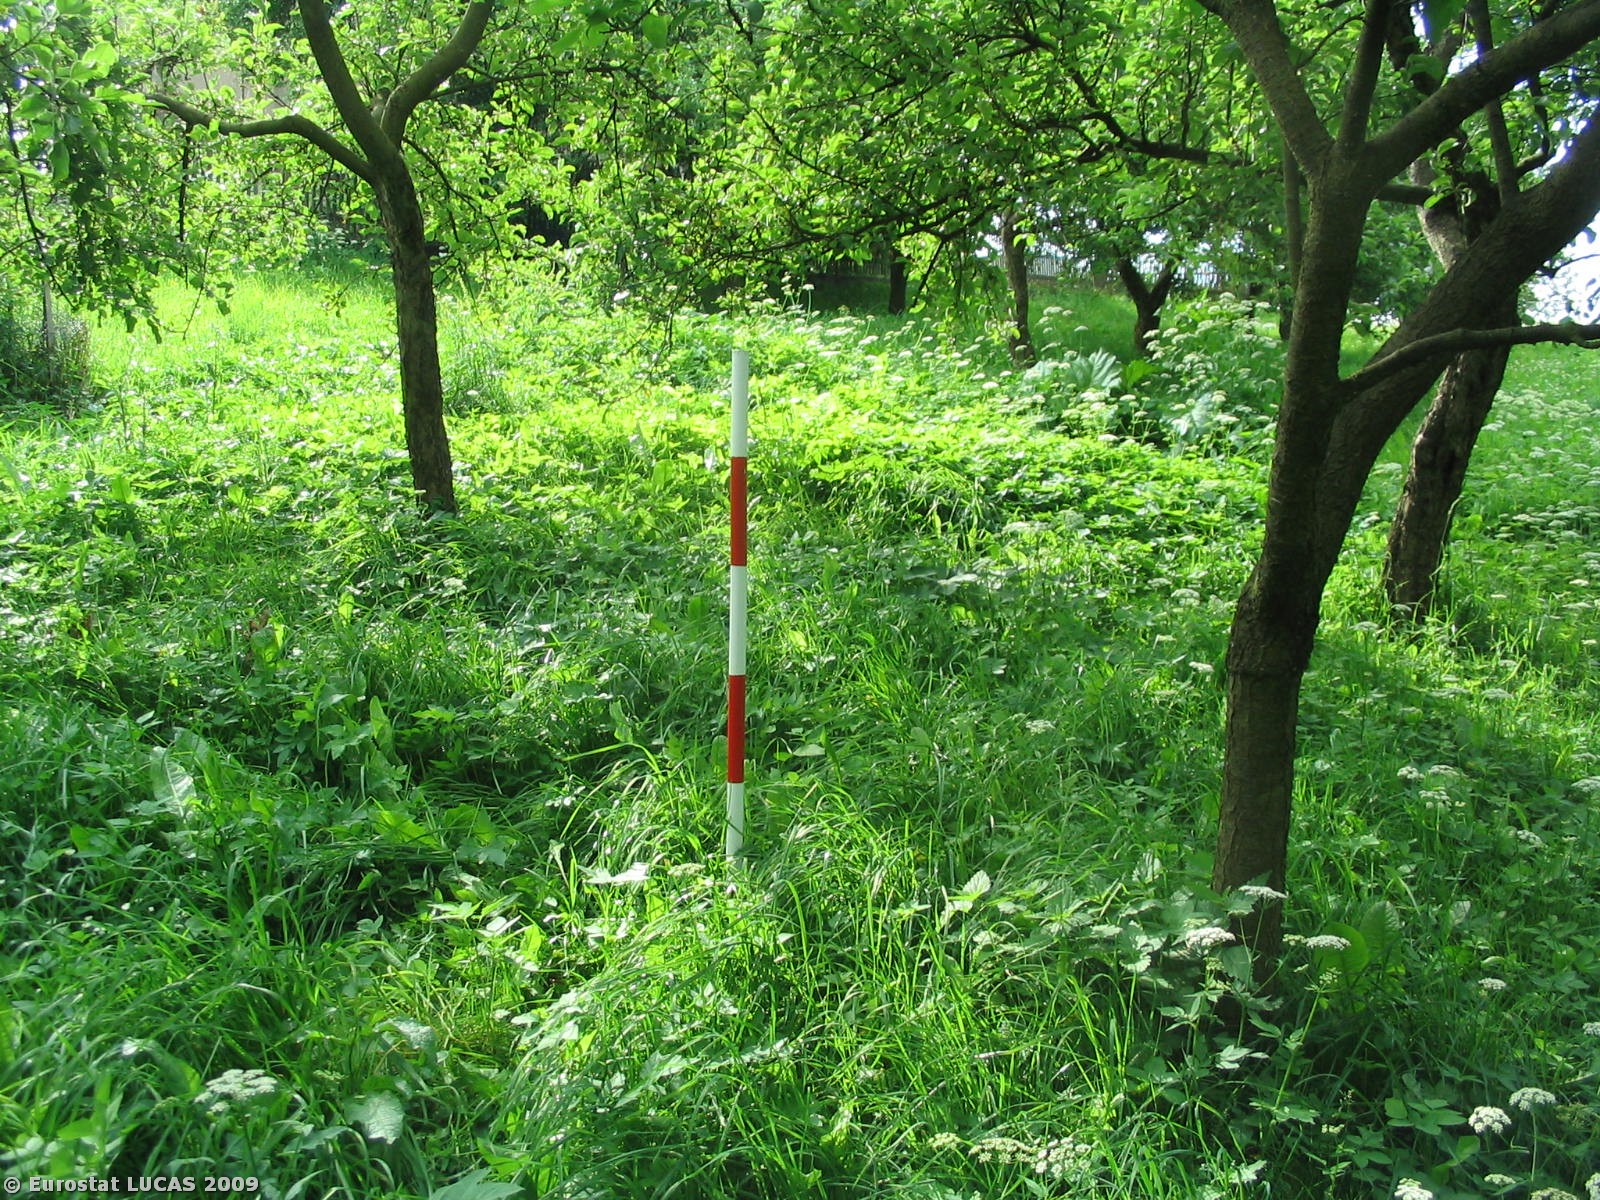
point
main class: Cropland
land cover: Apple fruit
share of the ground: 50 - 75 %
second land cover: Grassland with sparse tree/shrub cover
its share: > 75 %
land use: Kitchen garden
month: June
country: CZ
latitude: 49.5762
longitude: 18.7468
